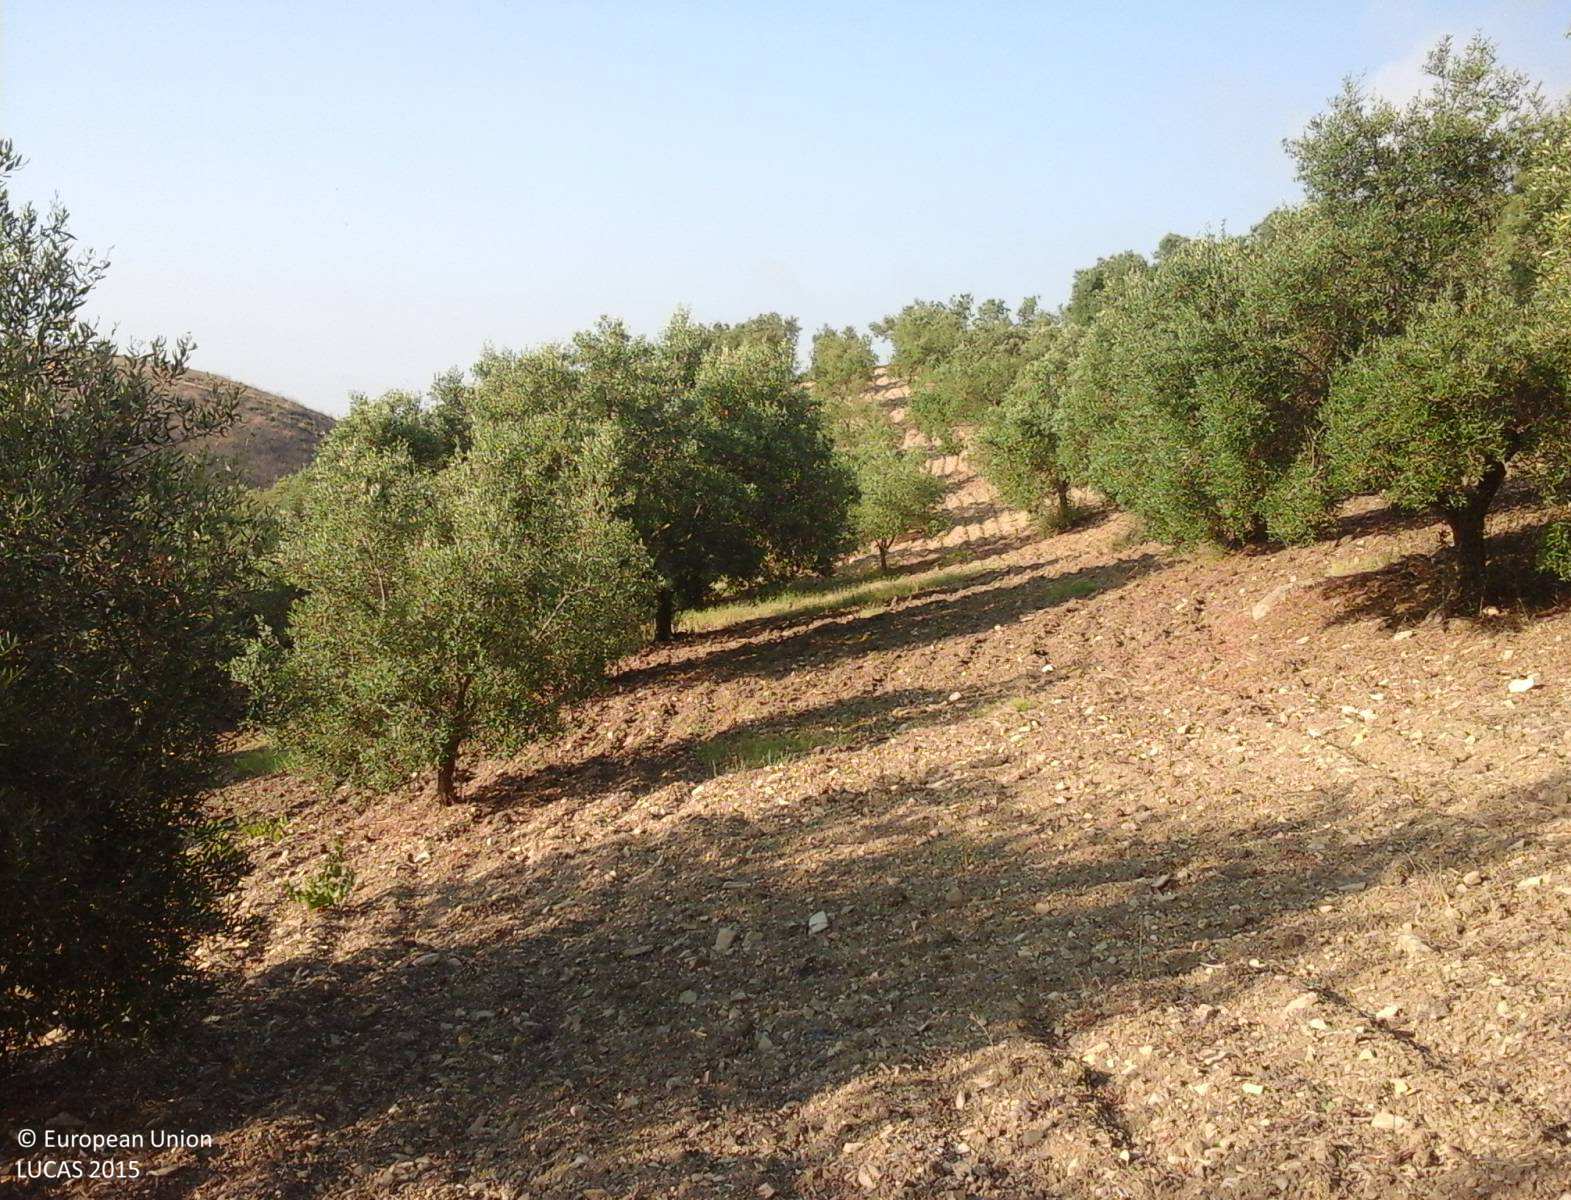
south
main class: Cropland
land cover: Olive groves
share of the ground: > 75 %
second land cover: Other bare soil
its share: > 75 %
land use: Agriculture (excluding fallow land and kitchen gardens)
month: July
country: IT
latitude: 39.6268
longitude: 8.8533
